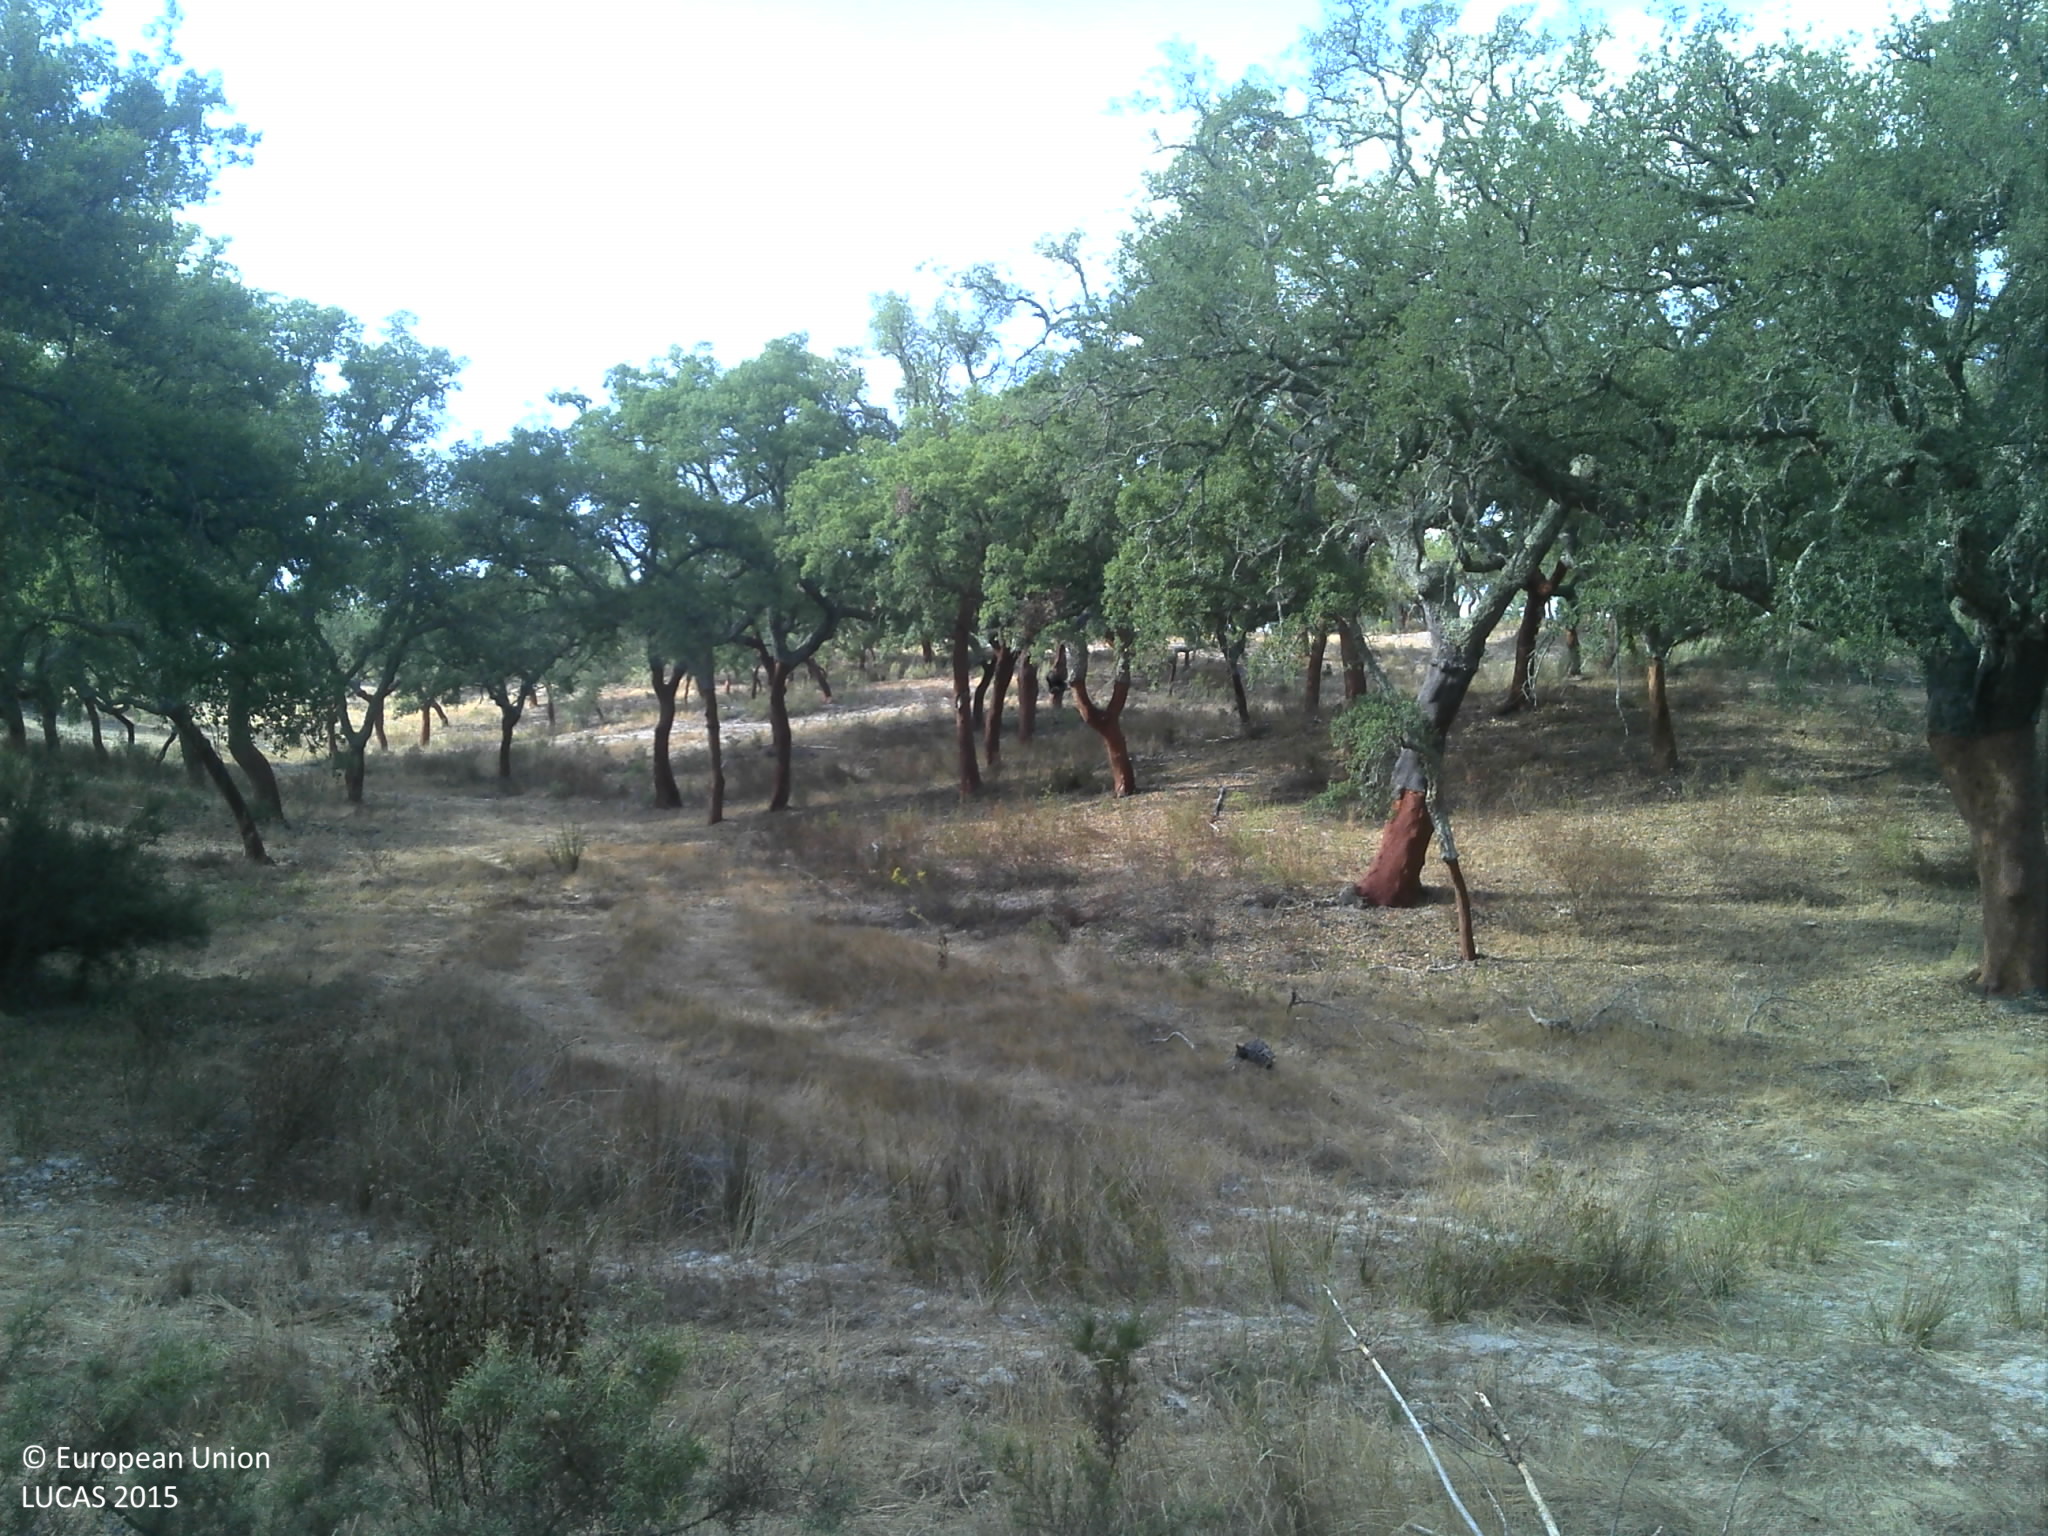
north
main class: Woodland
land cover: Broadleaved woodland
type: broadleaved evergreen forest
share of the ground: 50 - 75 %
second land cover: Grassland without tree/shrub cover
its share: 25 - 50 %
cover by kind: broadleaved forest trees 50 %, herbaceous plants 25 %, unconsolidated bare surface 25 %
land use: Forestry
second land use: Agriculture (excluding fallow land and kitchen gardens)
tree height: > 5 m
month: July
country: PT
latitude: 38.9019
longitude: -8.1908
